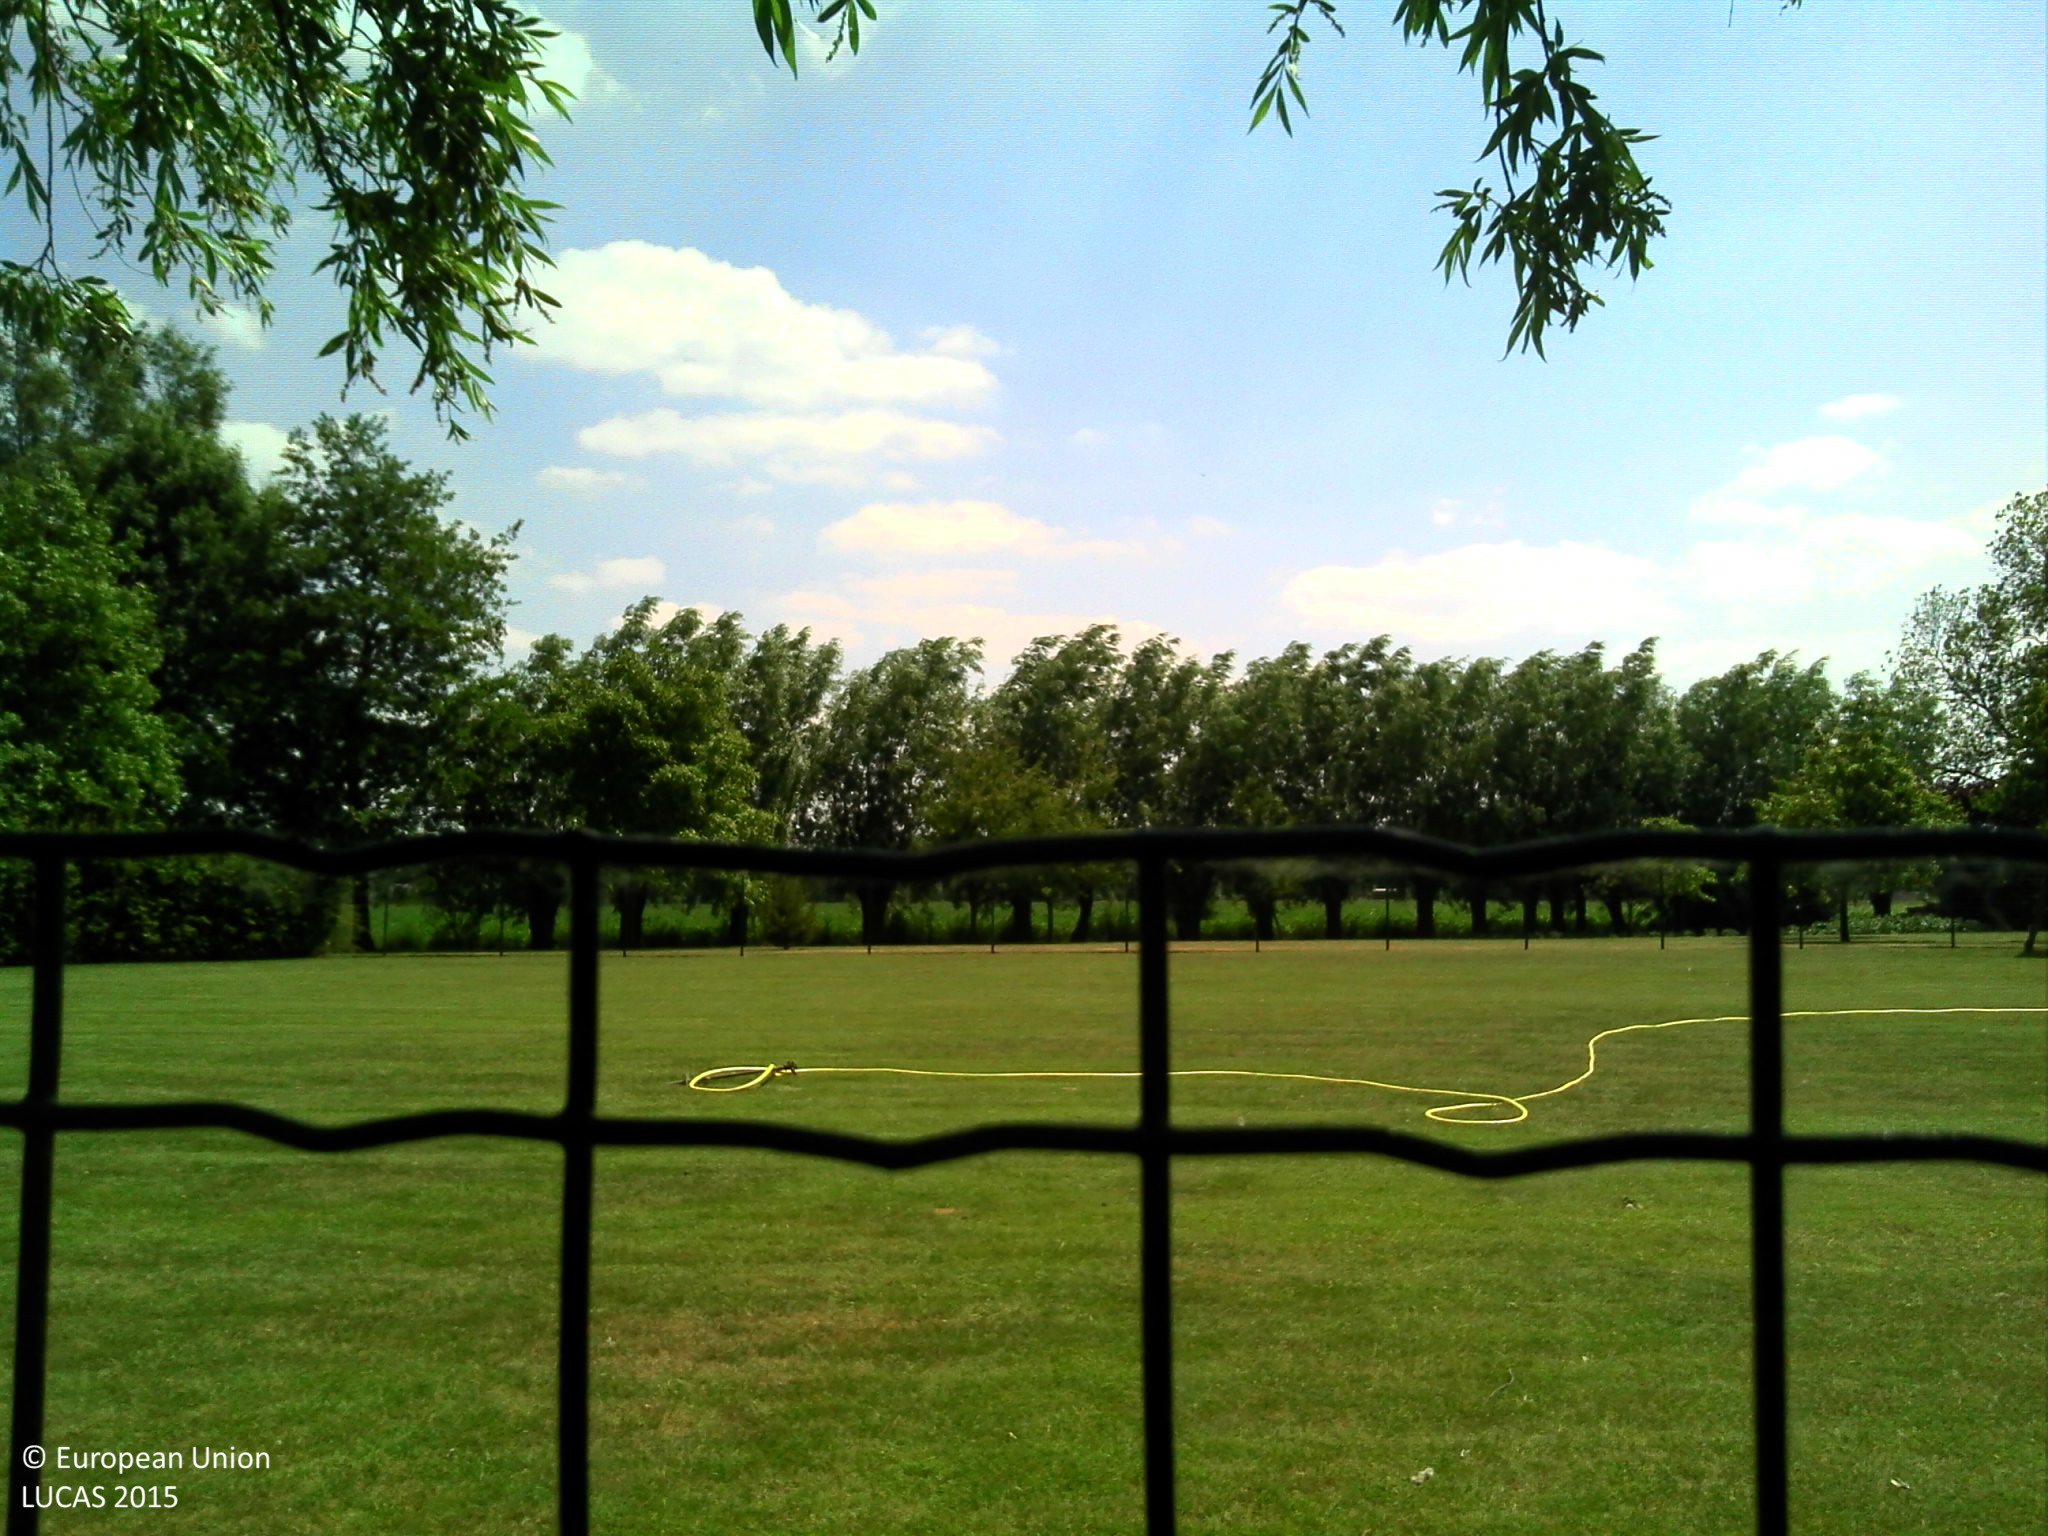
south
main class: Grassland
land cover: Grassland without tree/shrub cover
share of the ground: > 75 %
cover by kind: herbaceous plants 100 %
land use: Residential
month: June
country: BE
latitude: 51.0489
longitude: 3.9027
